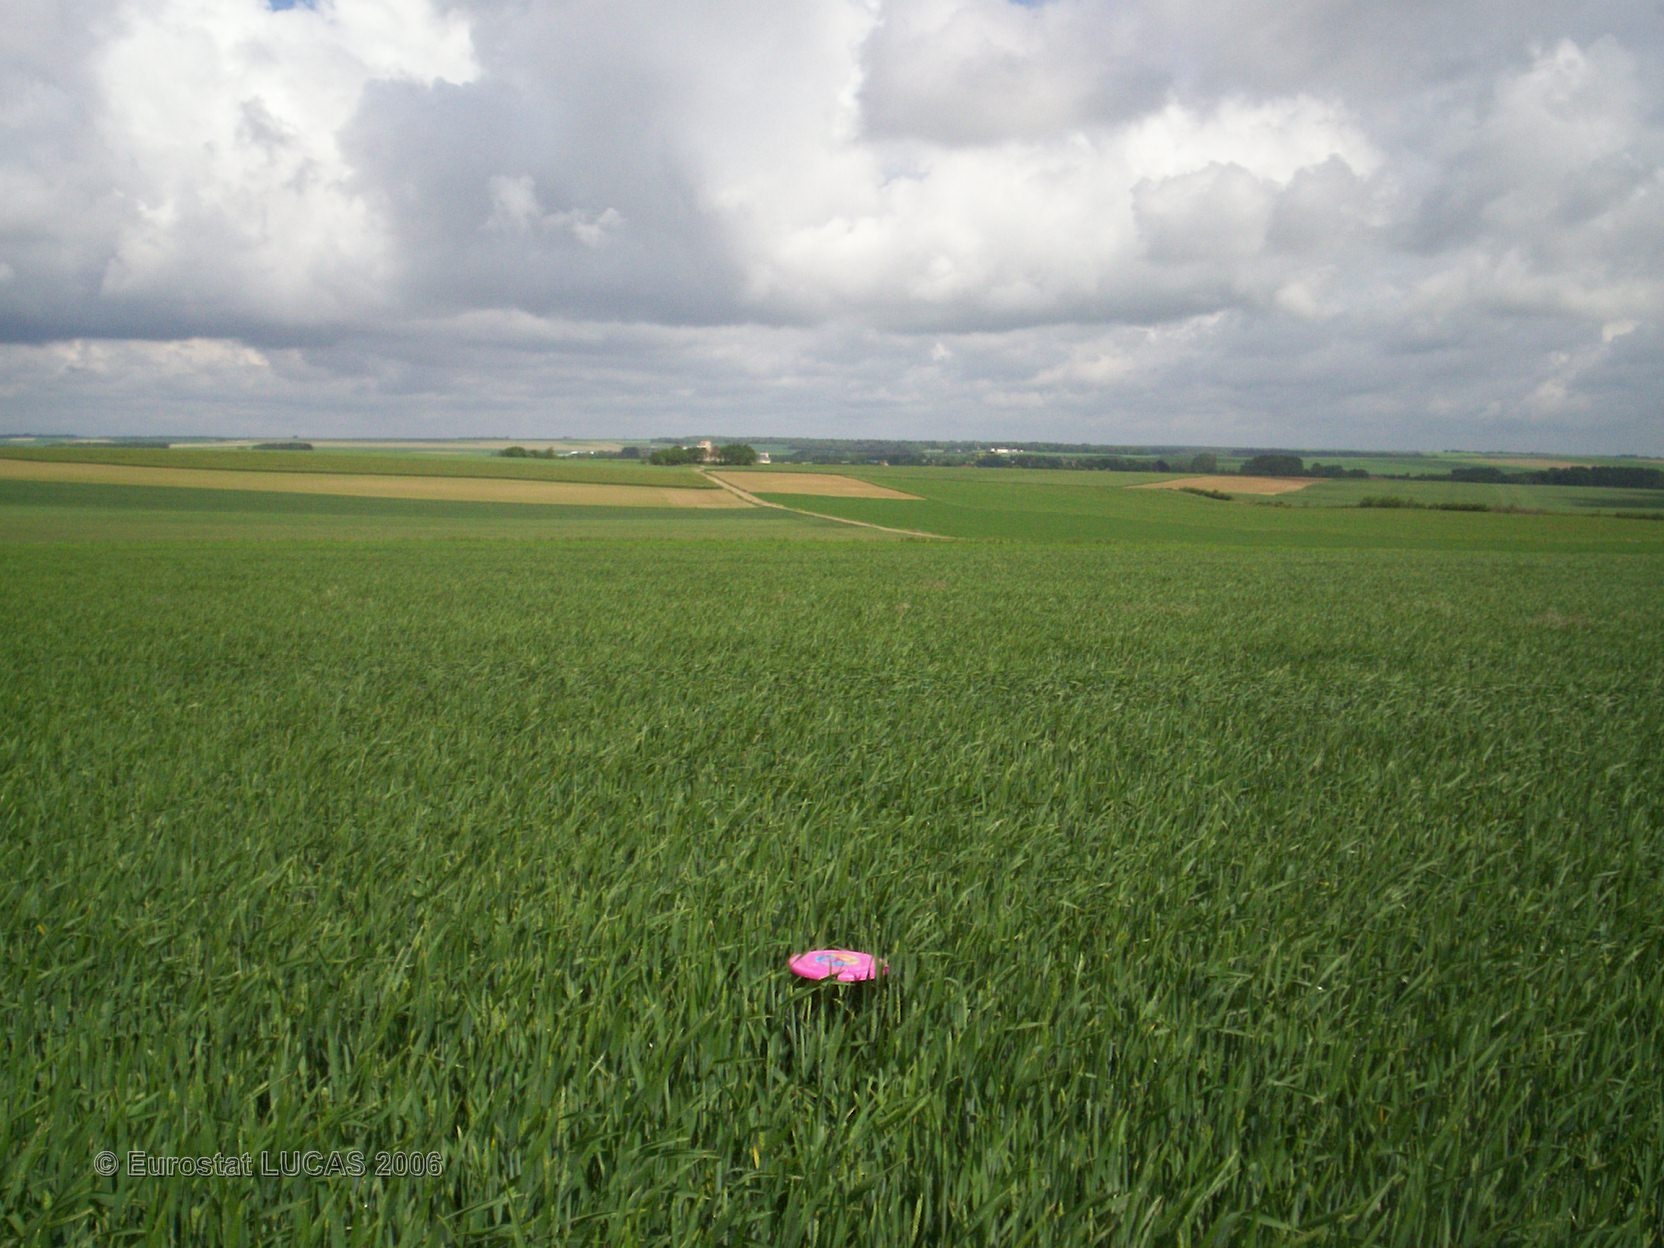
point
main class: Cropland
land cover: Common wheat
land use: Agriculture (excluding fallow land and kitchen gardens)
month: May
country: FR
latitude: 49.3791
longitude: 4.3900
